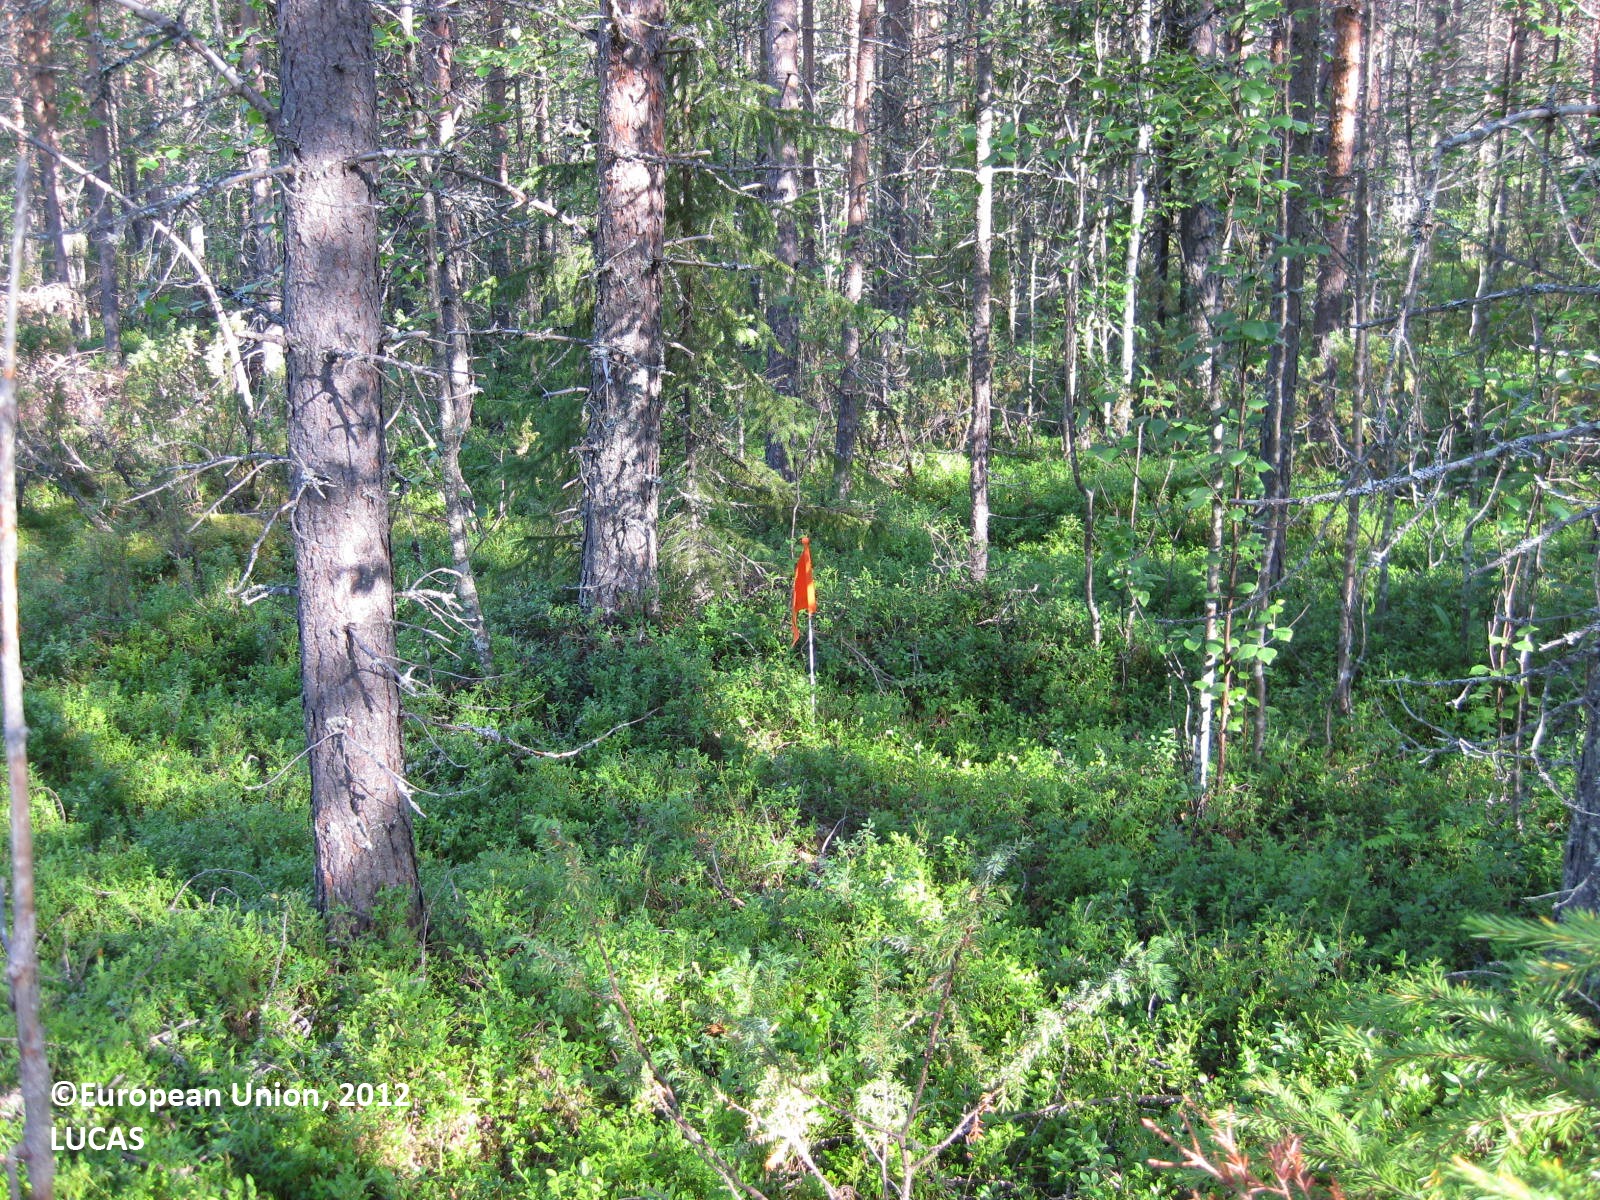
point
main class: Woodland
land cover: Pine dominated mixed woodland
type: boreal forest
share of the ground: > 75 %
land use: Forestry
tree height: > 5 m
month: July
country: FI
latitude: 65.6310
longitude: 28.3336
